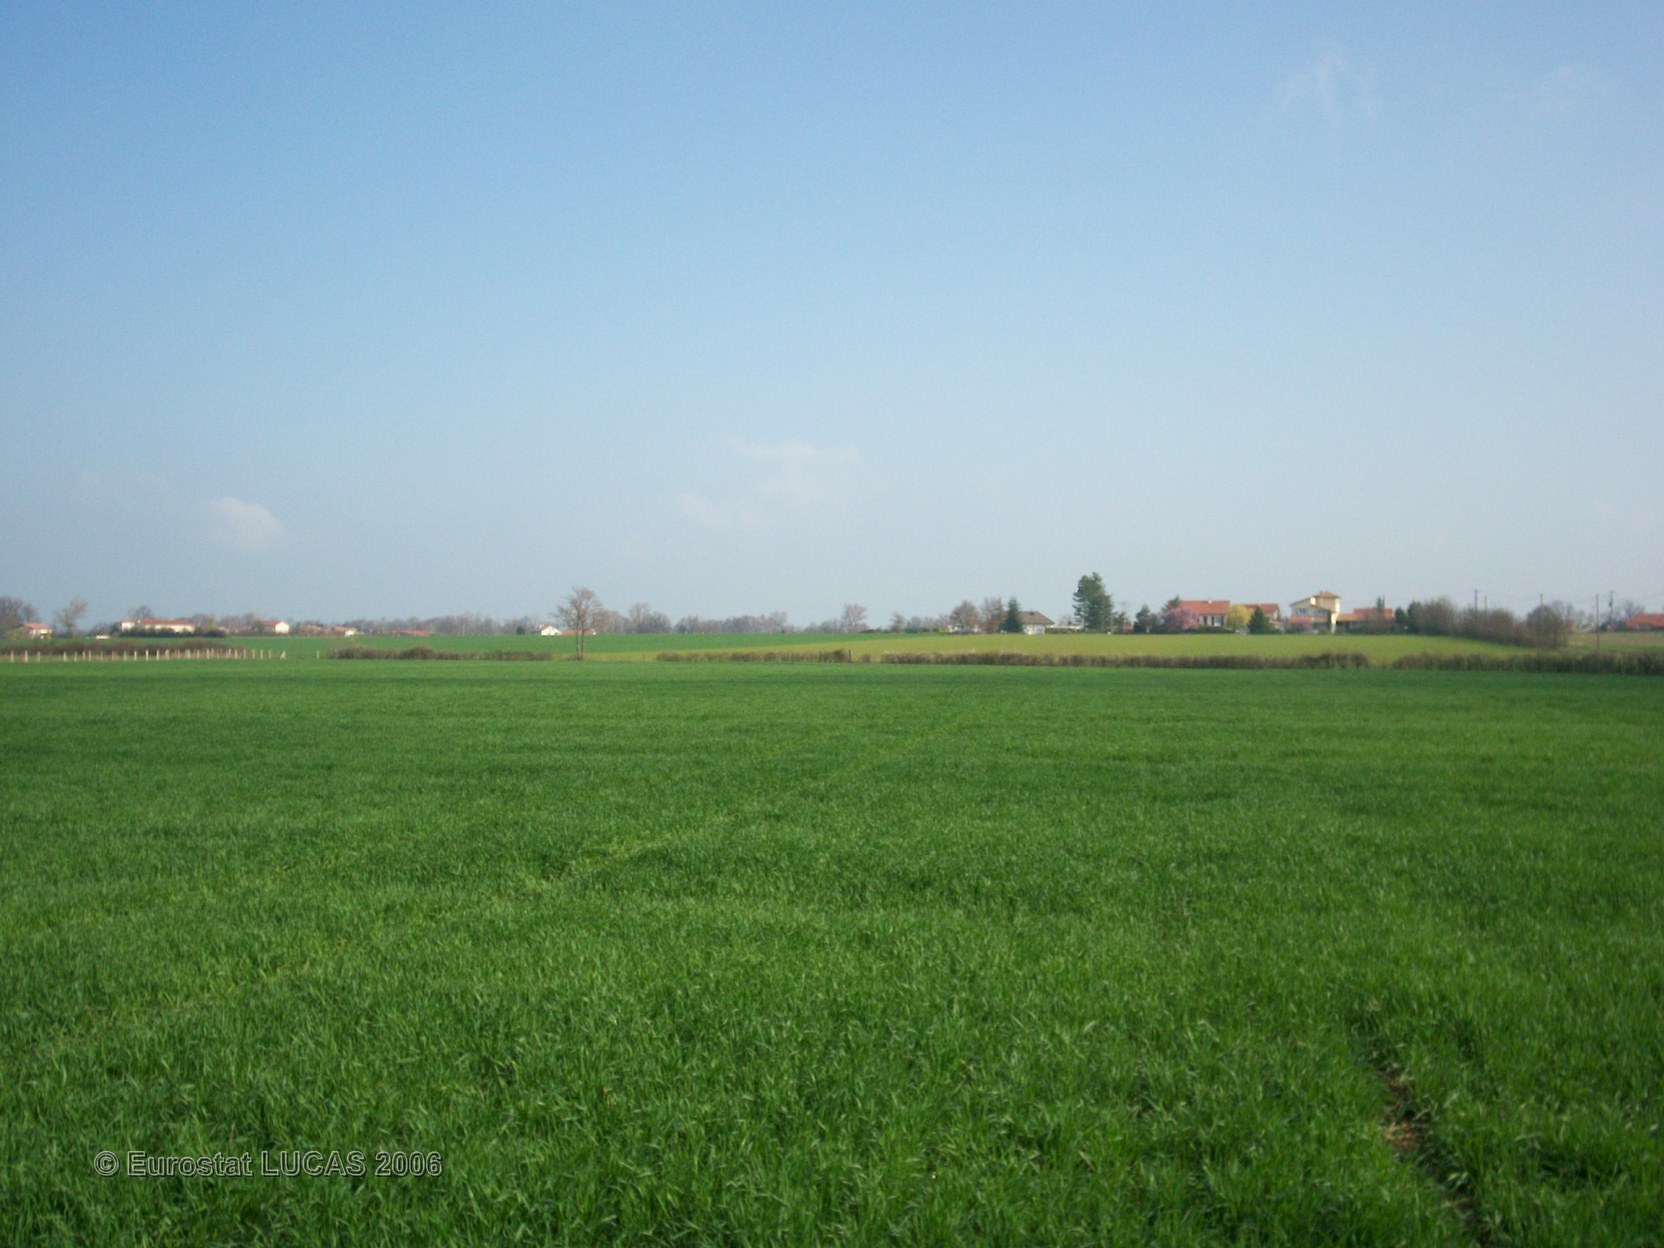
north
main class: Cropland
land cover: Common wheat
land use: Agriculture (excluding fallow land and kitchen gardens)
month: April
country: FR
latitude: 45.5768
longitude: 4.1465
